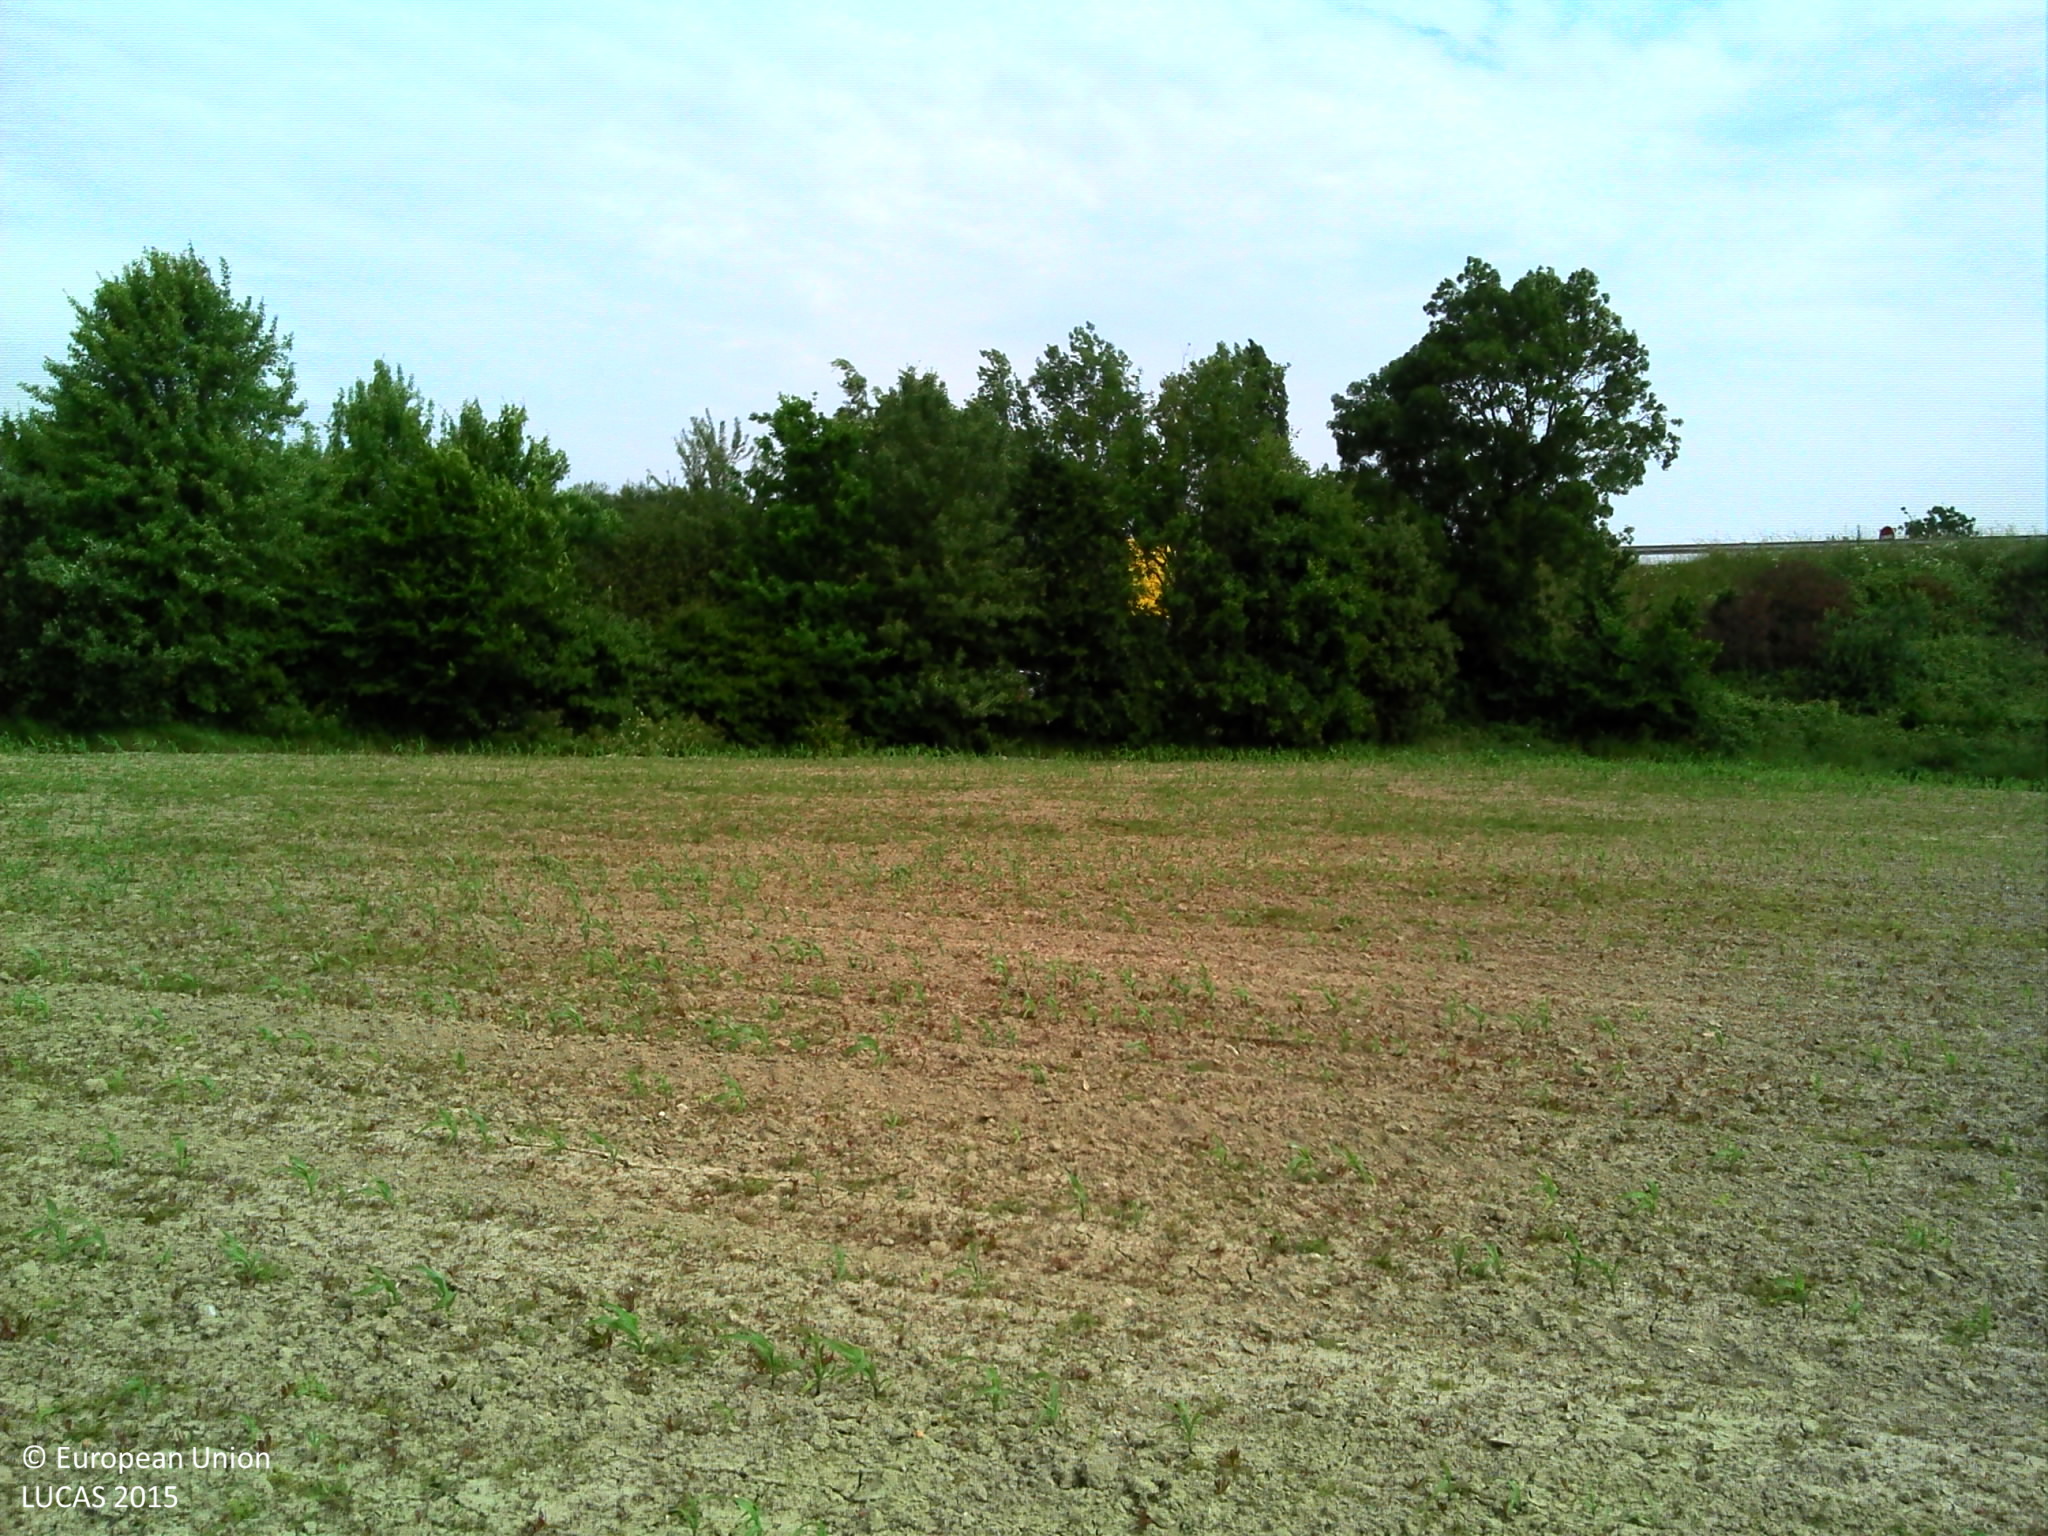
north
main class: Cropland
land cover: Maize
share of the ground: 10 - 25 %
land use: Agriculture (excluding fallow land and kitchen gardens)
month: June
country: FR
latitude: 47.1047
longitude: -2.0524
